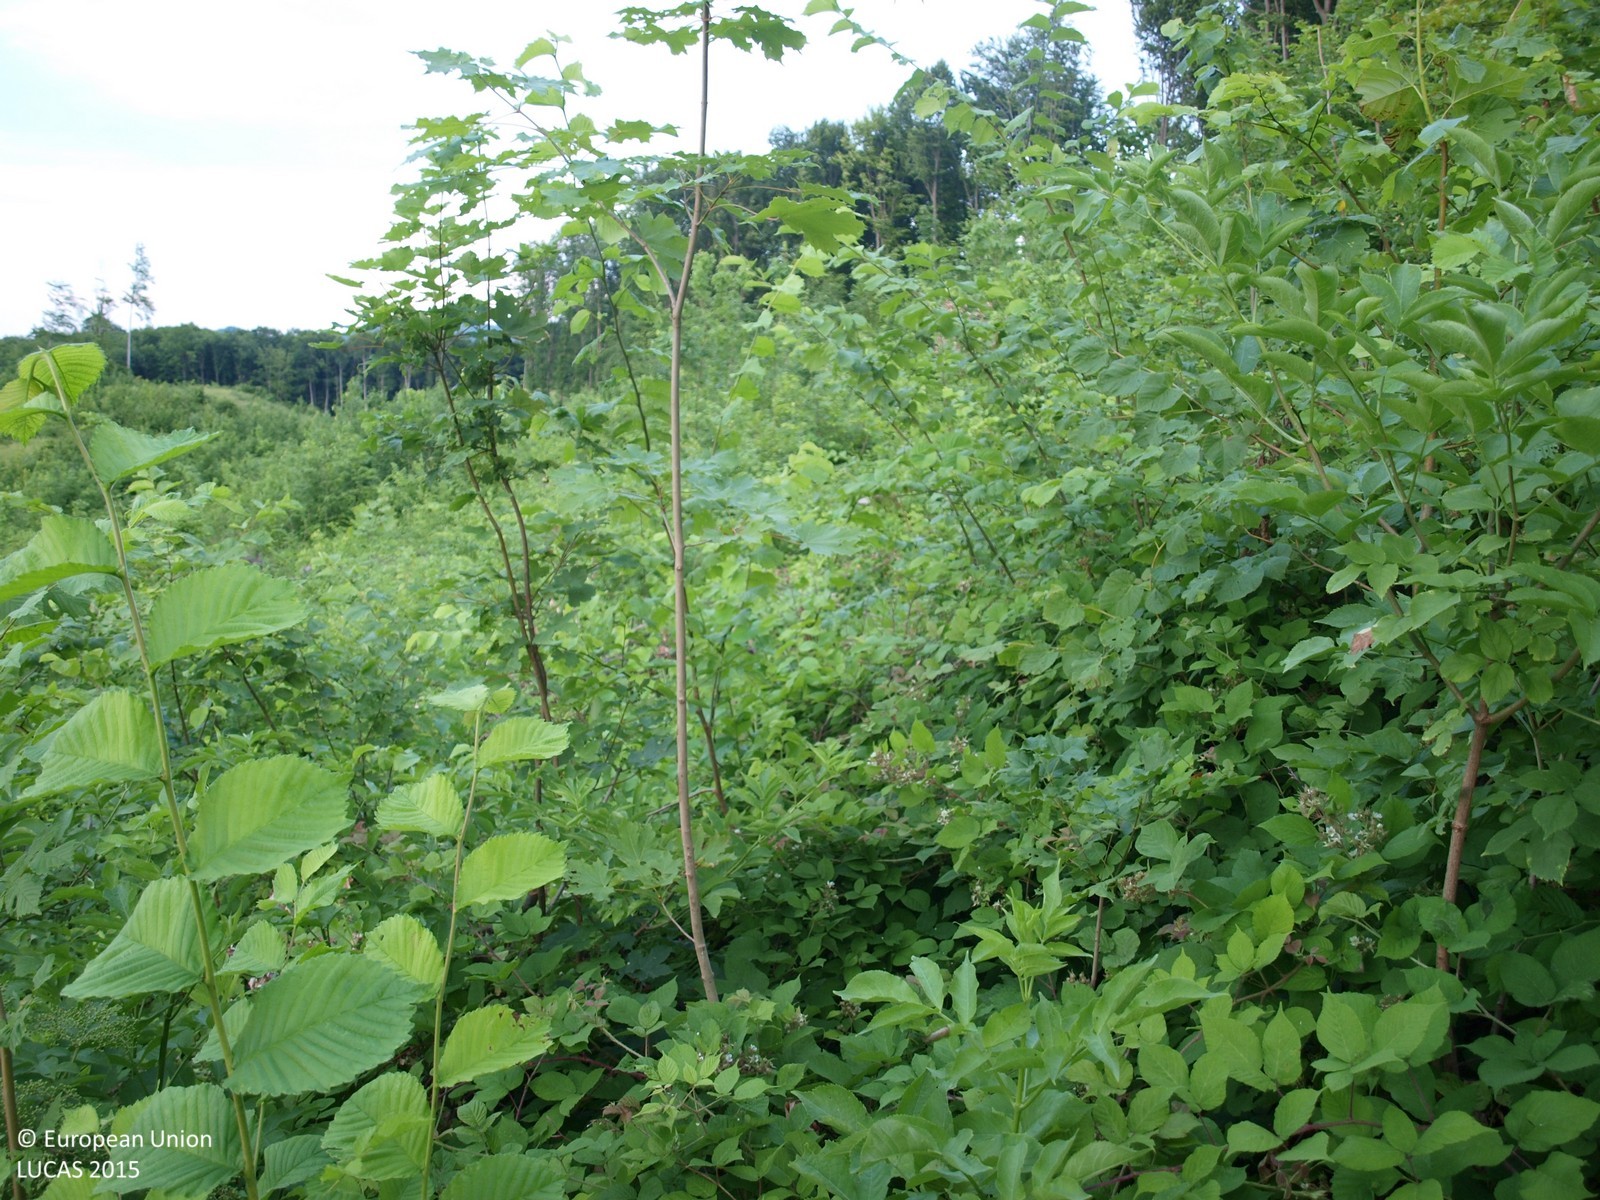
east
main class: Woodland
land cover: Broadleaved woodland
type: beech forest
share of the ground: > 75 %
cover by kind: broadleaved forest trees 100 %
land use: Forestry
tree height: > 5 m
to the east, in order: Broadleaved woodland; Tracks; Broadleaved woodland
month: June
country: HR
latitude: 46.1753
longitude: 16.4379
